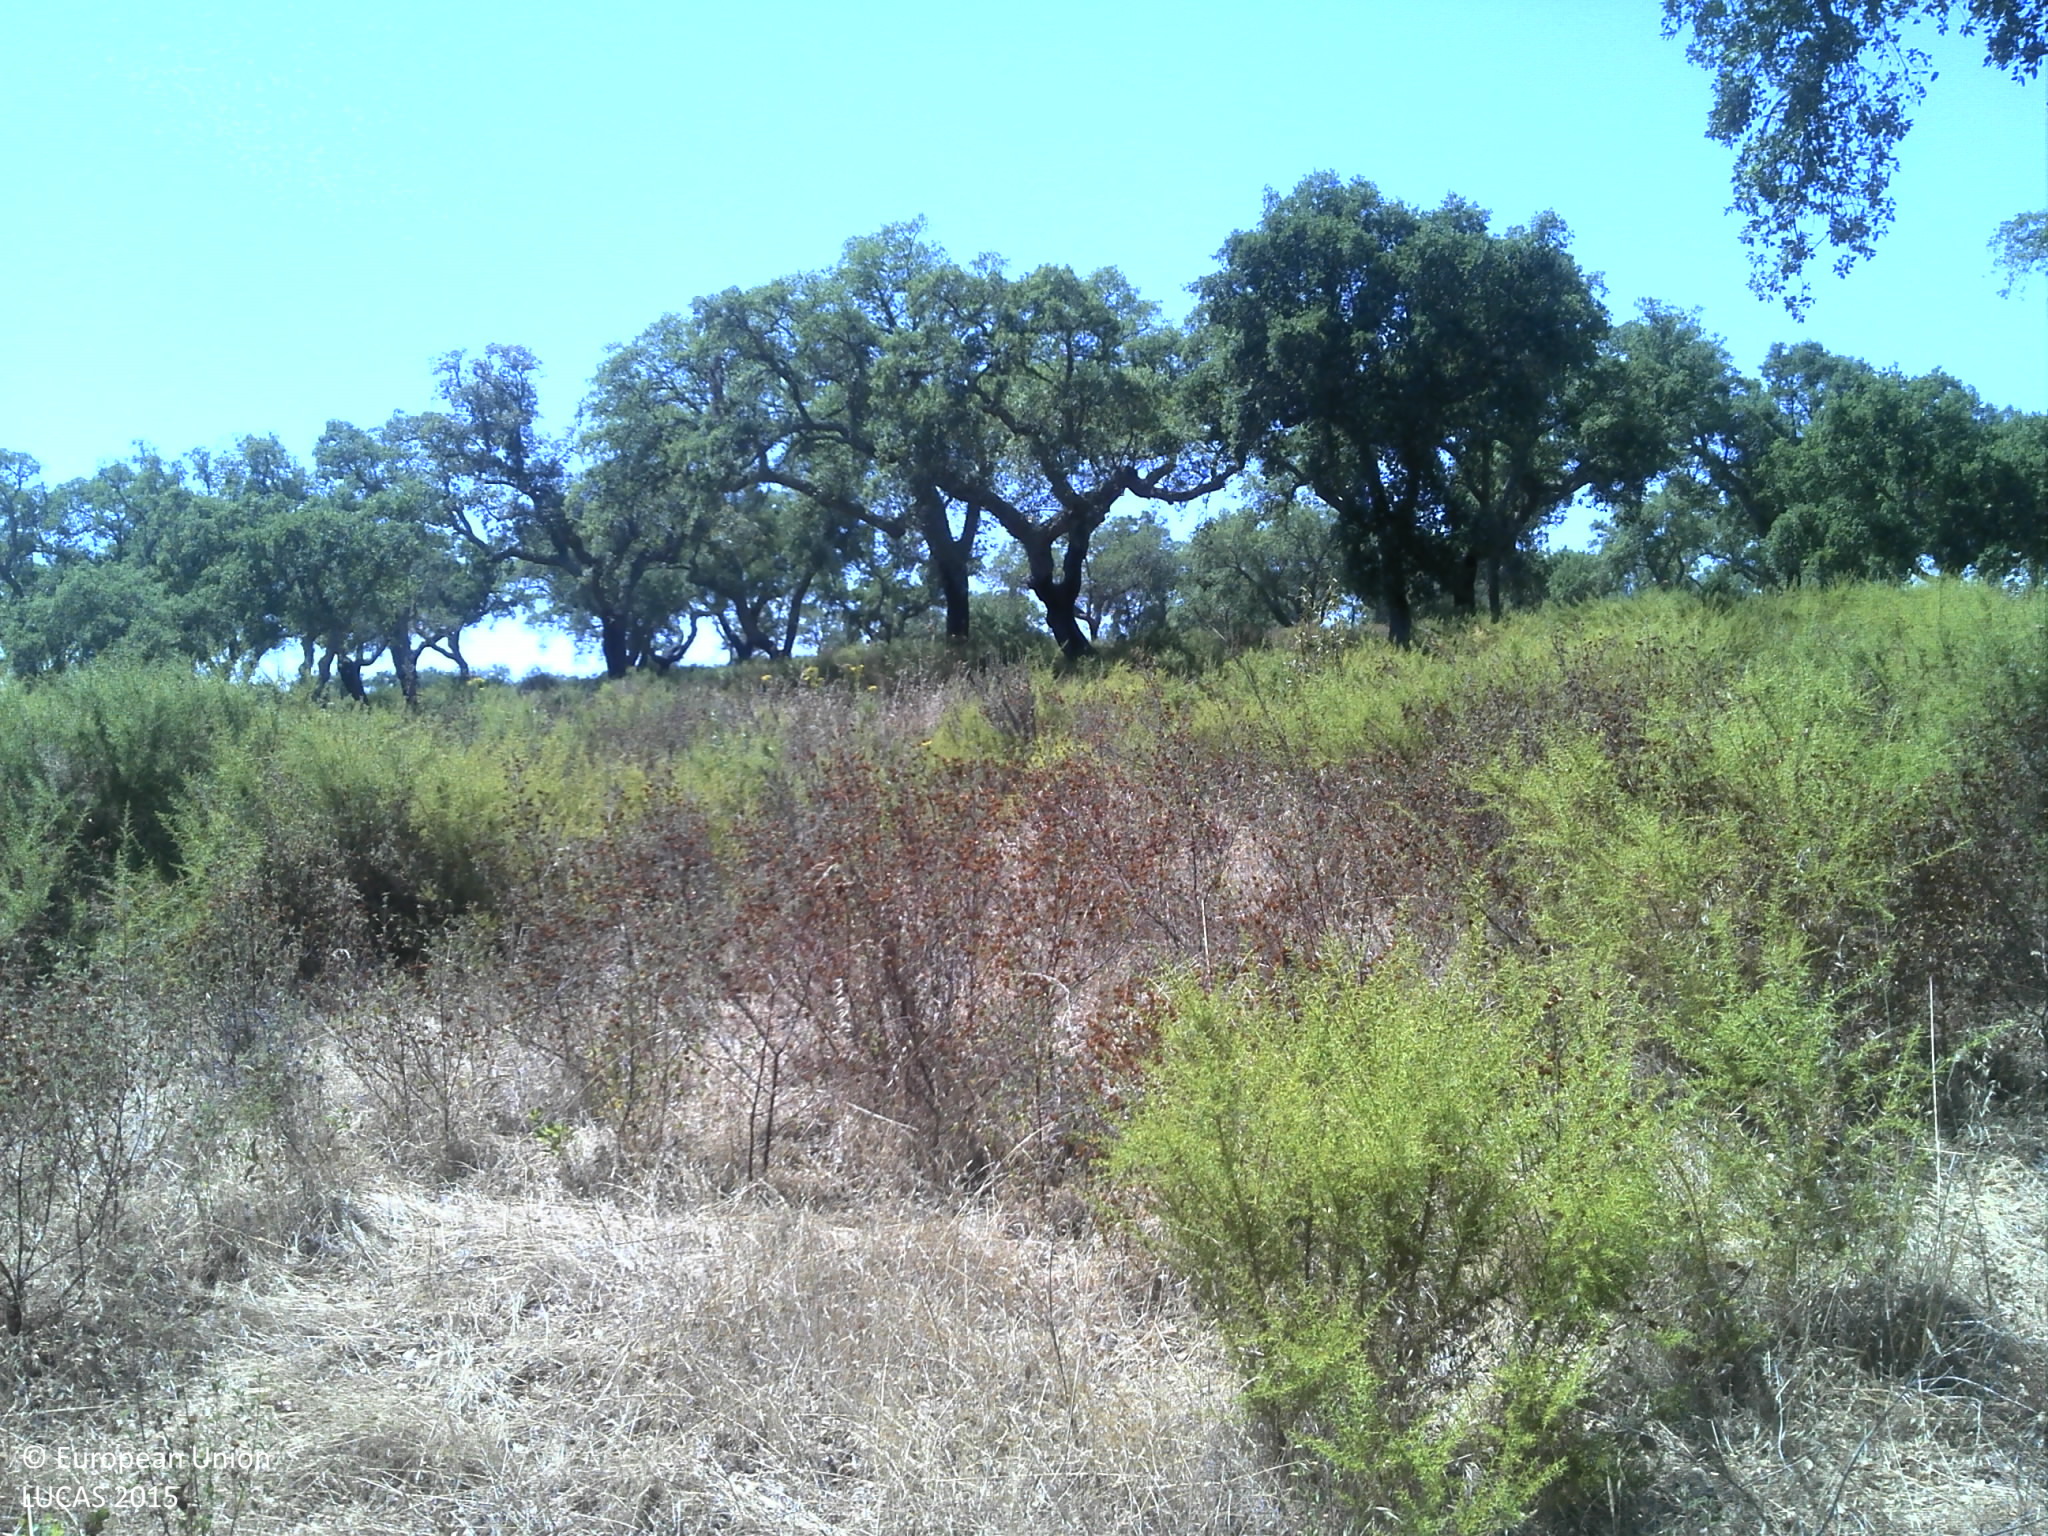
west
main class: Woodland
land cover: Broadleaved woodland
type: broadleaved evergreen forest
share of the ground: 25 - 50 %
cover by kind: broadleaved forest trees 45 %, unconsolidated bare surface 35 %, herbaceous plants 20 %
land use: Forestry
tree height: > 5 m
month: July
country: PT
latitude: 39.0157
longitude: -8.1755
